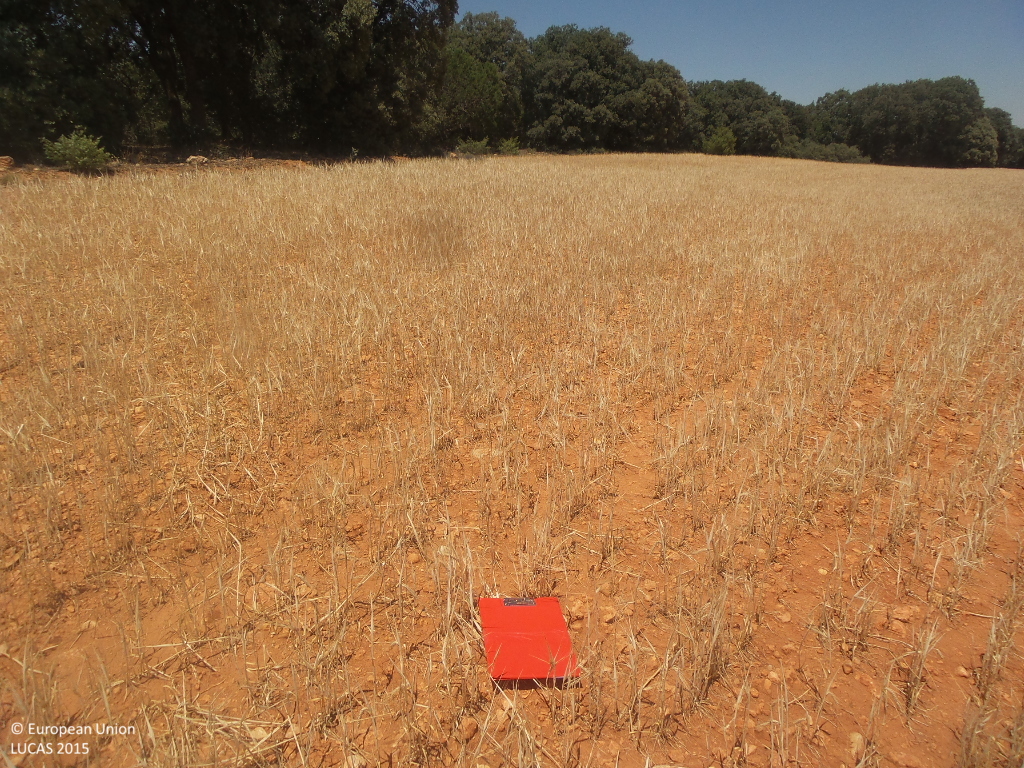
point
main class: Cropland
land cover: Barley
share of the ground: 50 - 75 %
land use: Agriculture (excluding fallow land and kitchen gardens)
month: July
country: ES
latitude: 41.1685
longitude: -2.1738
